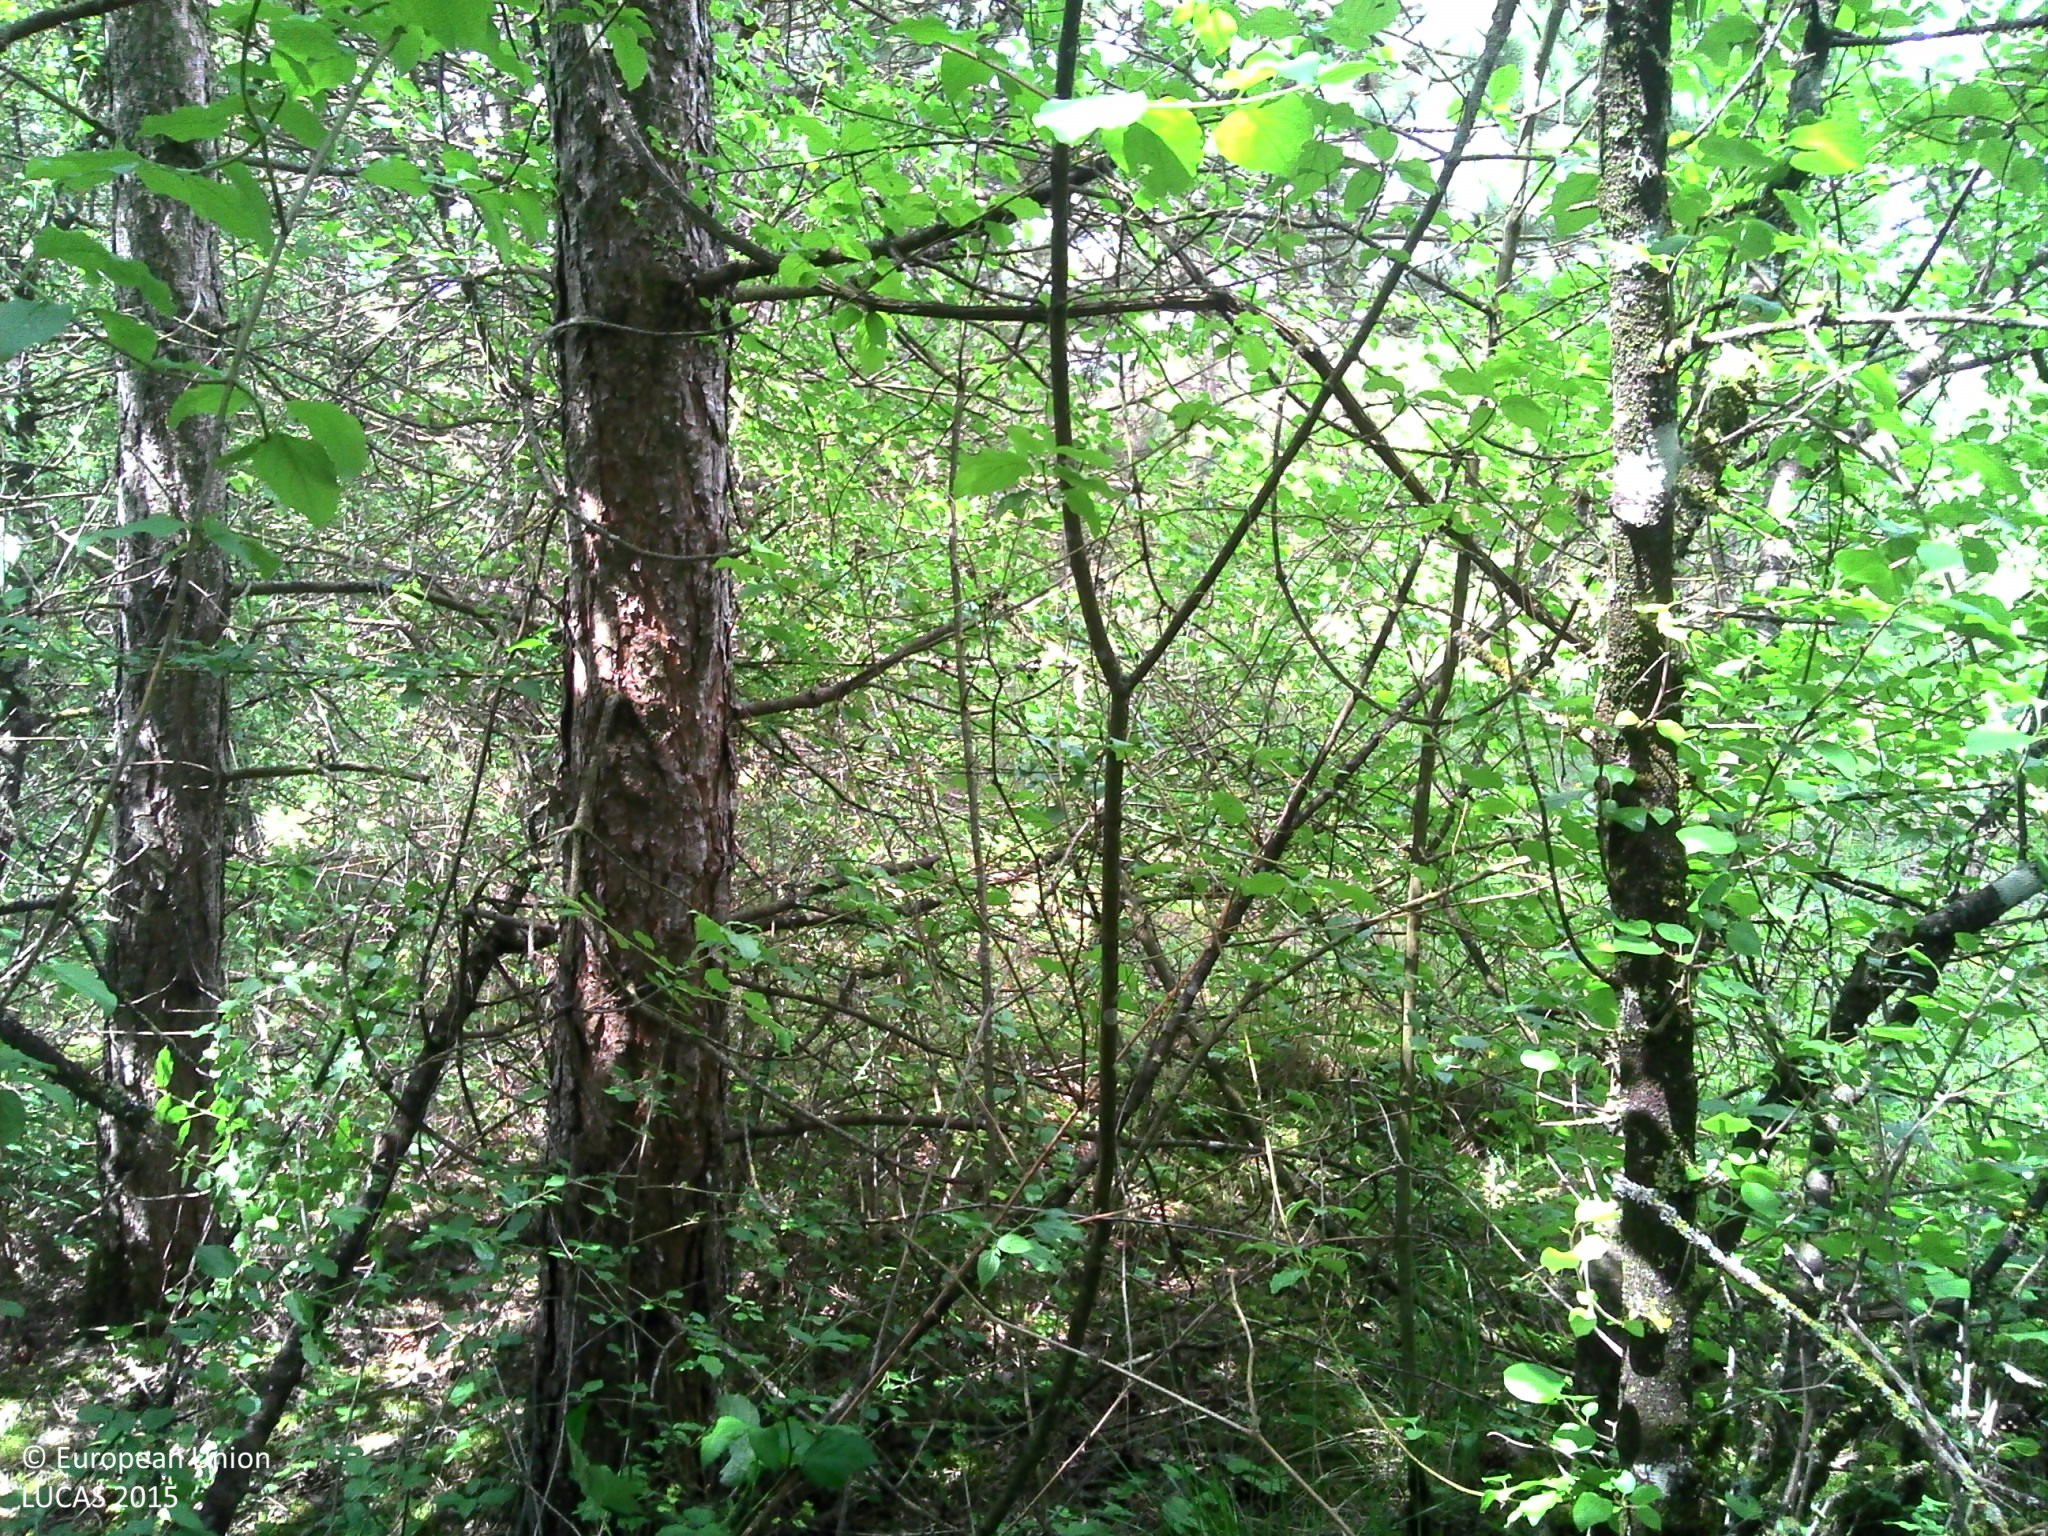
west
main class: Woodland
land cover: Pine dominated mixed woodland
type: exotic forest
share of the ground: > 75 %
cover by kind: coniferous forest trees 60 %, broadleaved forest trees 30 %, herbaceous plants 5 %, lichens and mosses 5 %
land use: Forestry
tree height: > 5 m
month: May
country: FR
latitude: 47.7135
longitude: 3.9323
